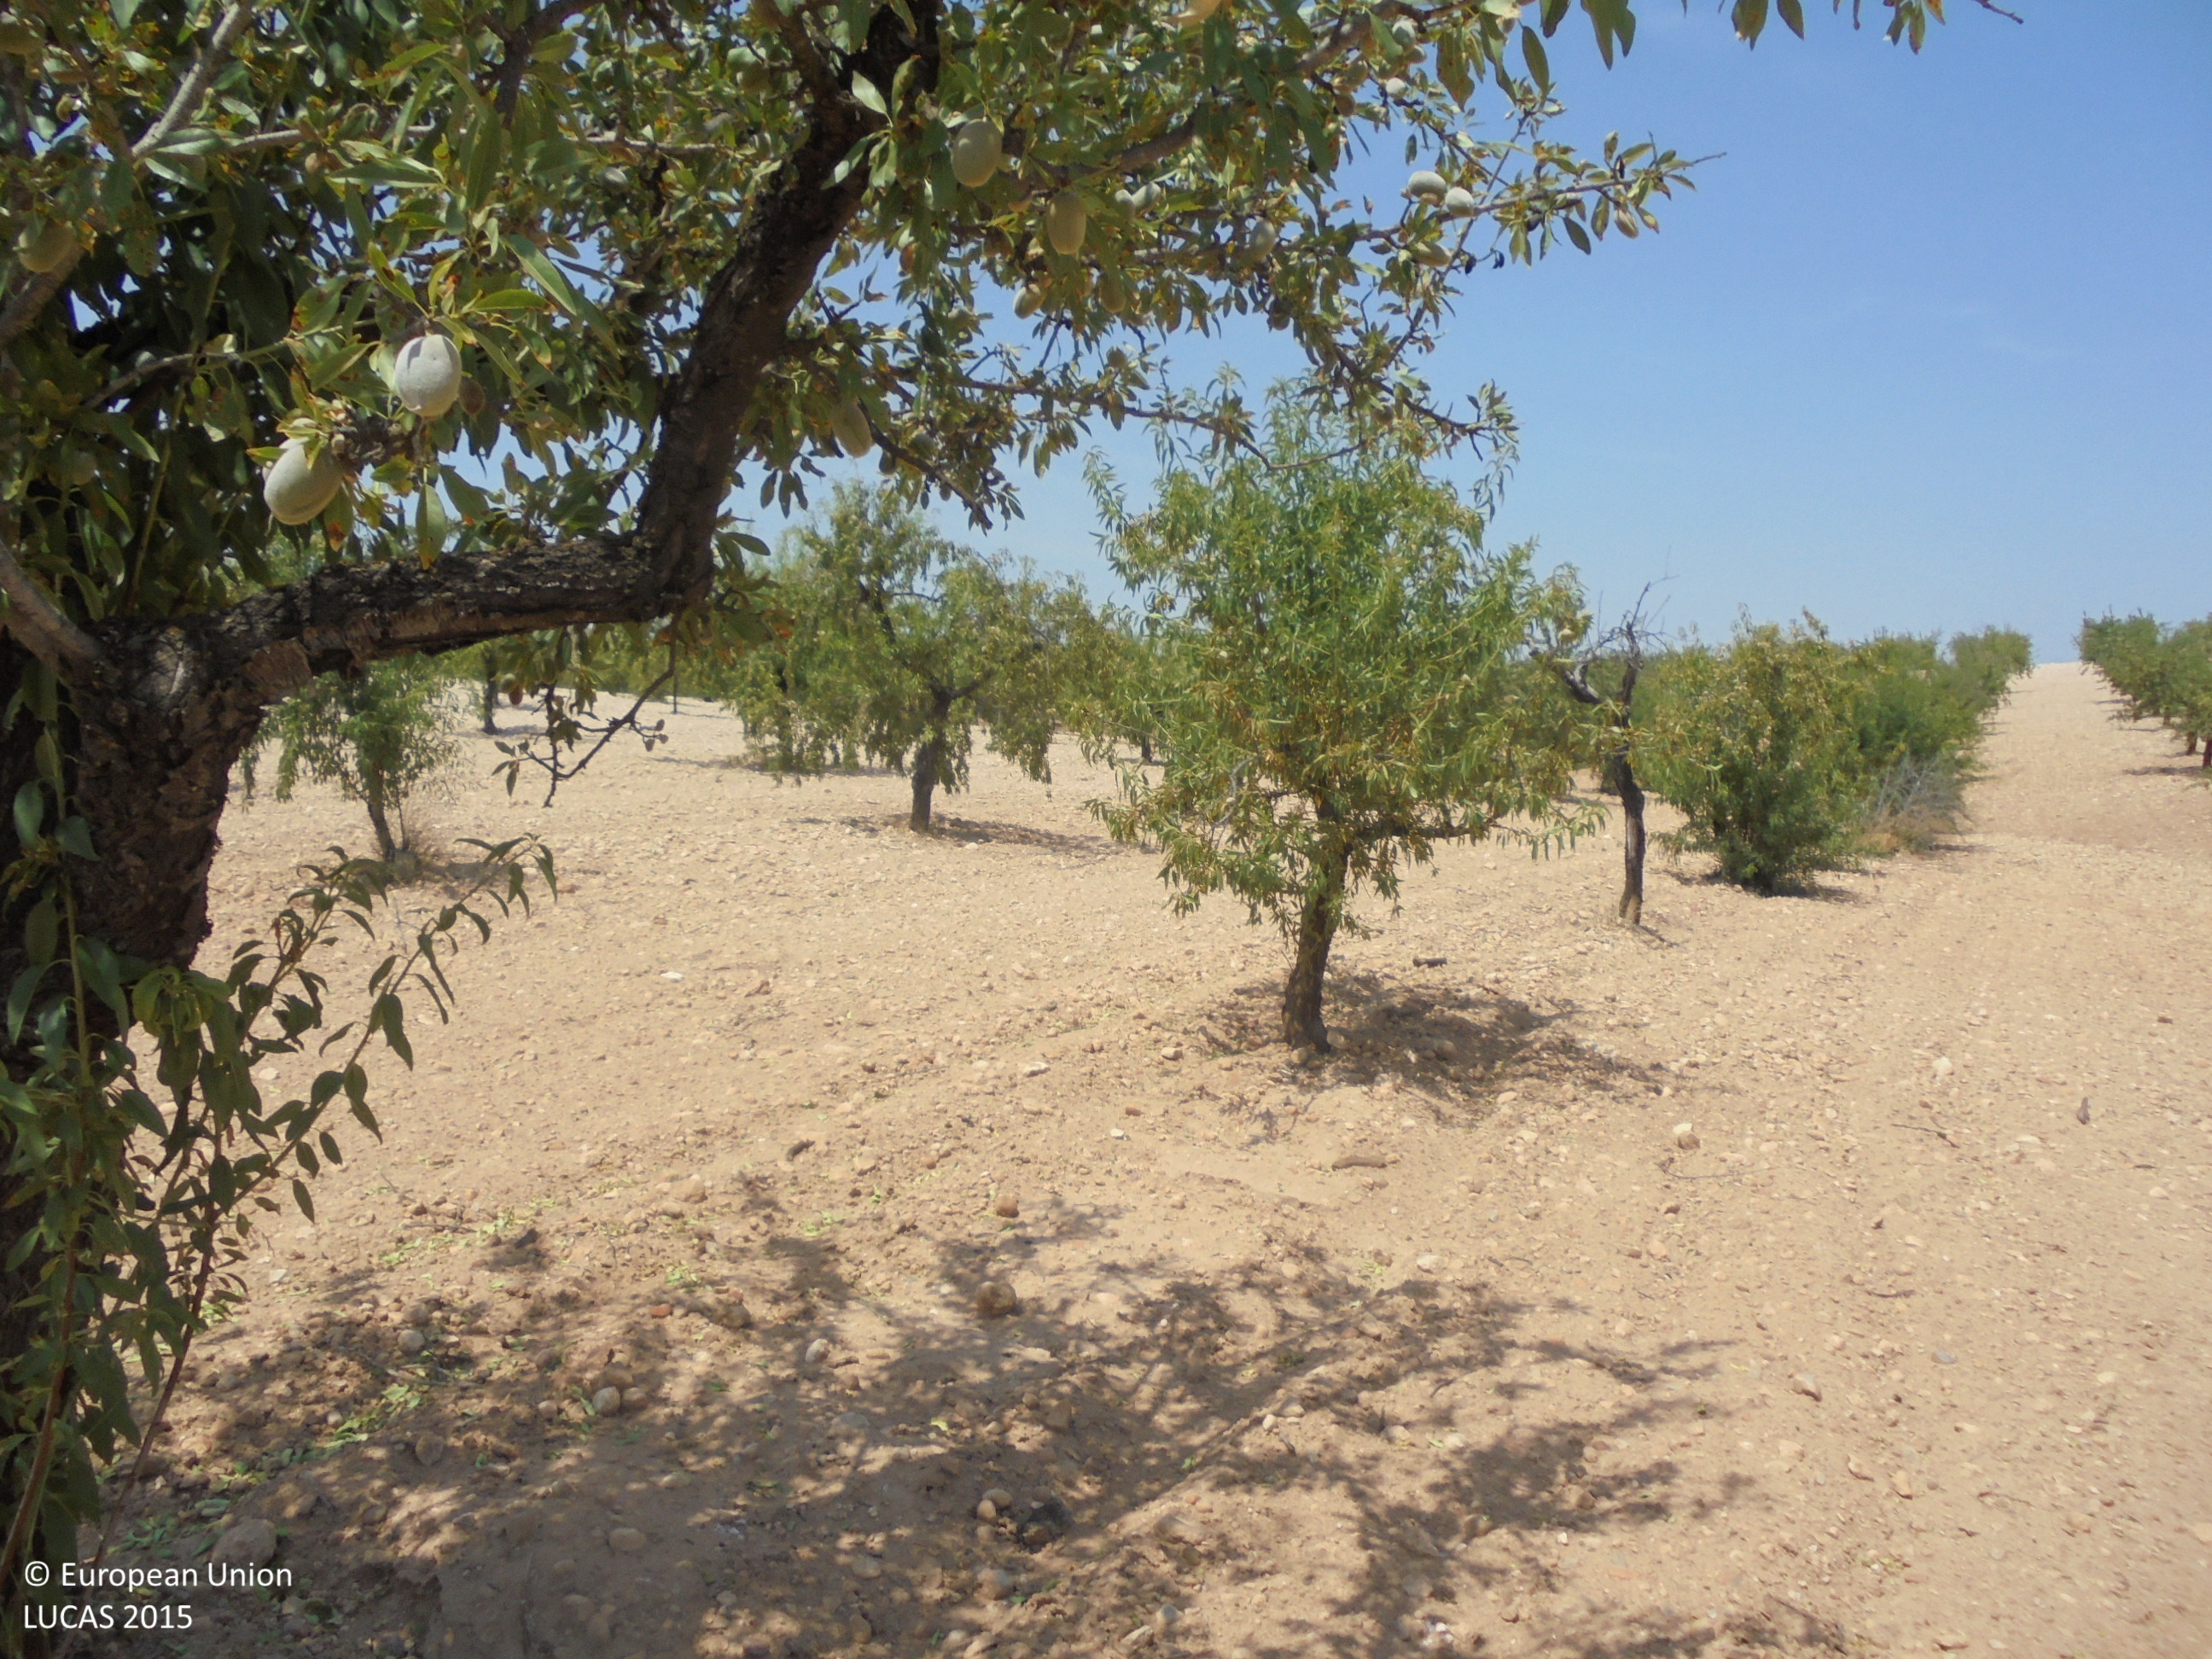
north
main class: Cropland
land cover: Nuts trees
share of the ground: 25 - 50 %
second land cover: Other bare soil
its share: > 75 %
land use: Agriculture (excluding fallow land and kitchen gardens)
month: July
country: ES
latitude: 38.5611
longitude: -1.6881
